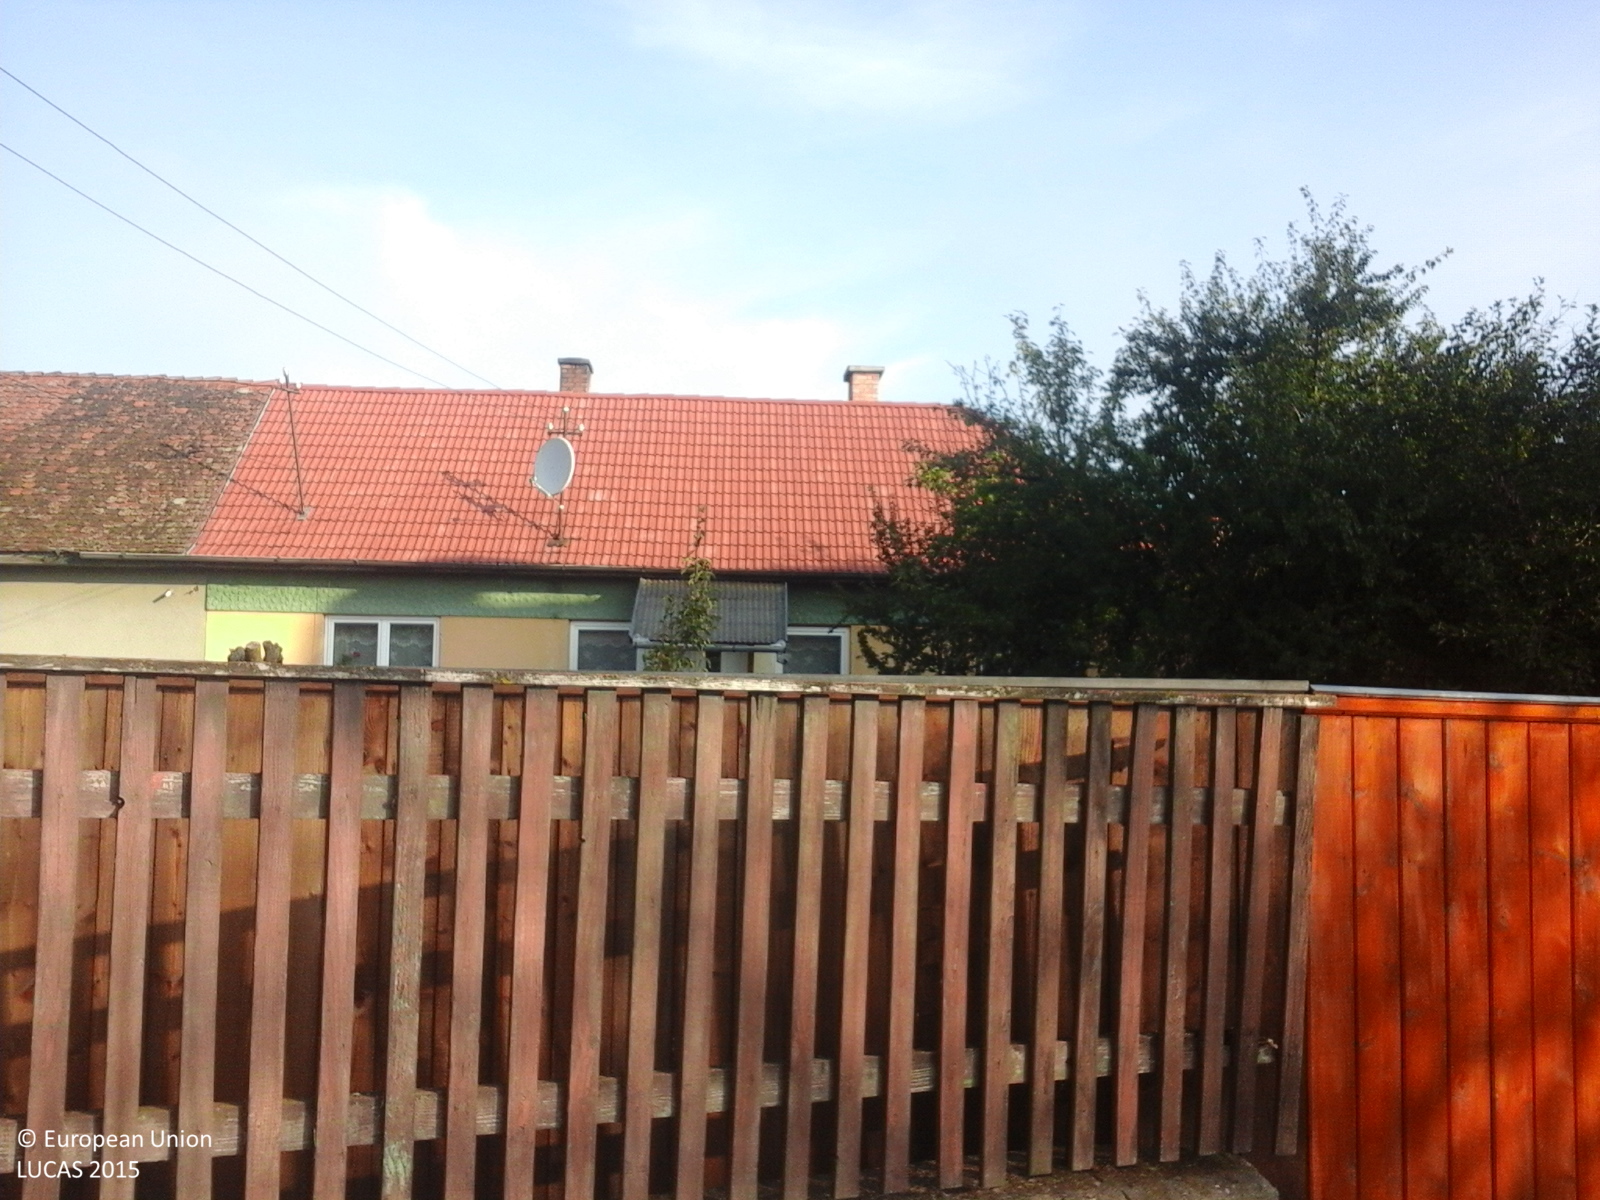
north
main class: Grassland
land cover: Grassland without tree/shrub cover
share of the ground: > 75 %
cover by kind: herbaceous plants 100 %
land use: Agriculture (excluding fallow land and kitchen gardens)
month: October
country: RO
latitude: 46.2562
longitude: 25.8776
